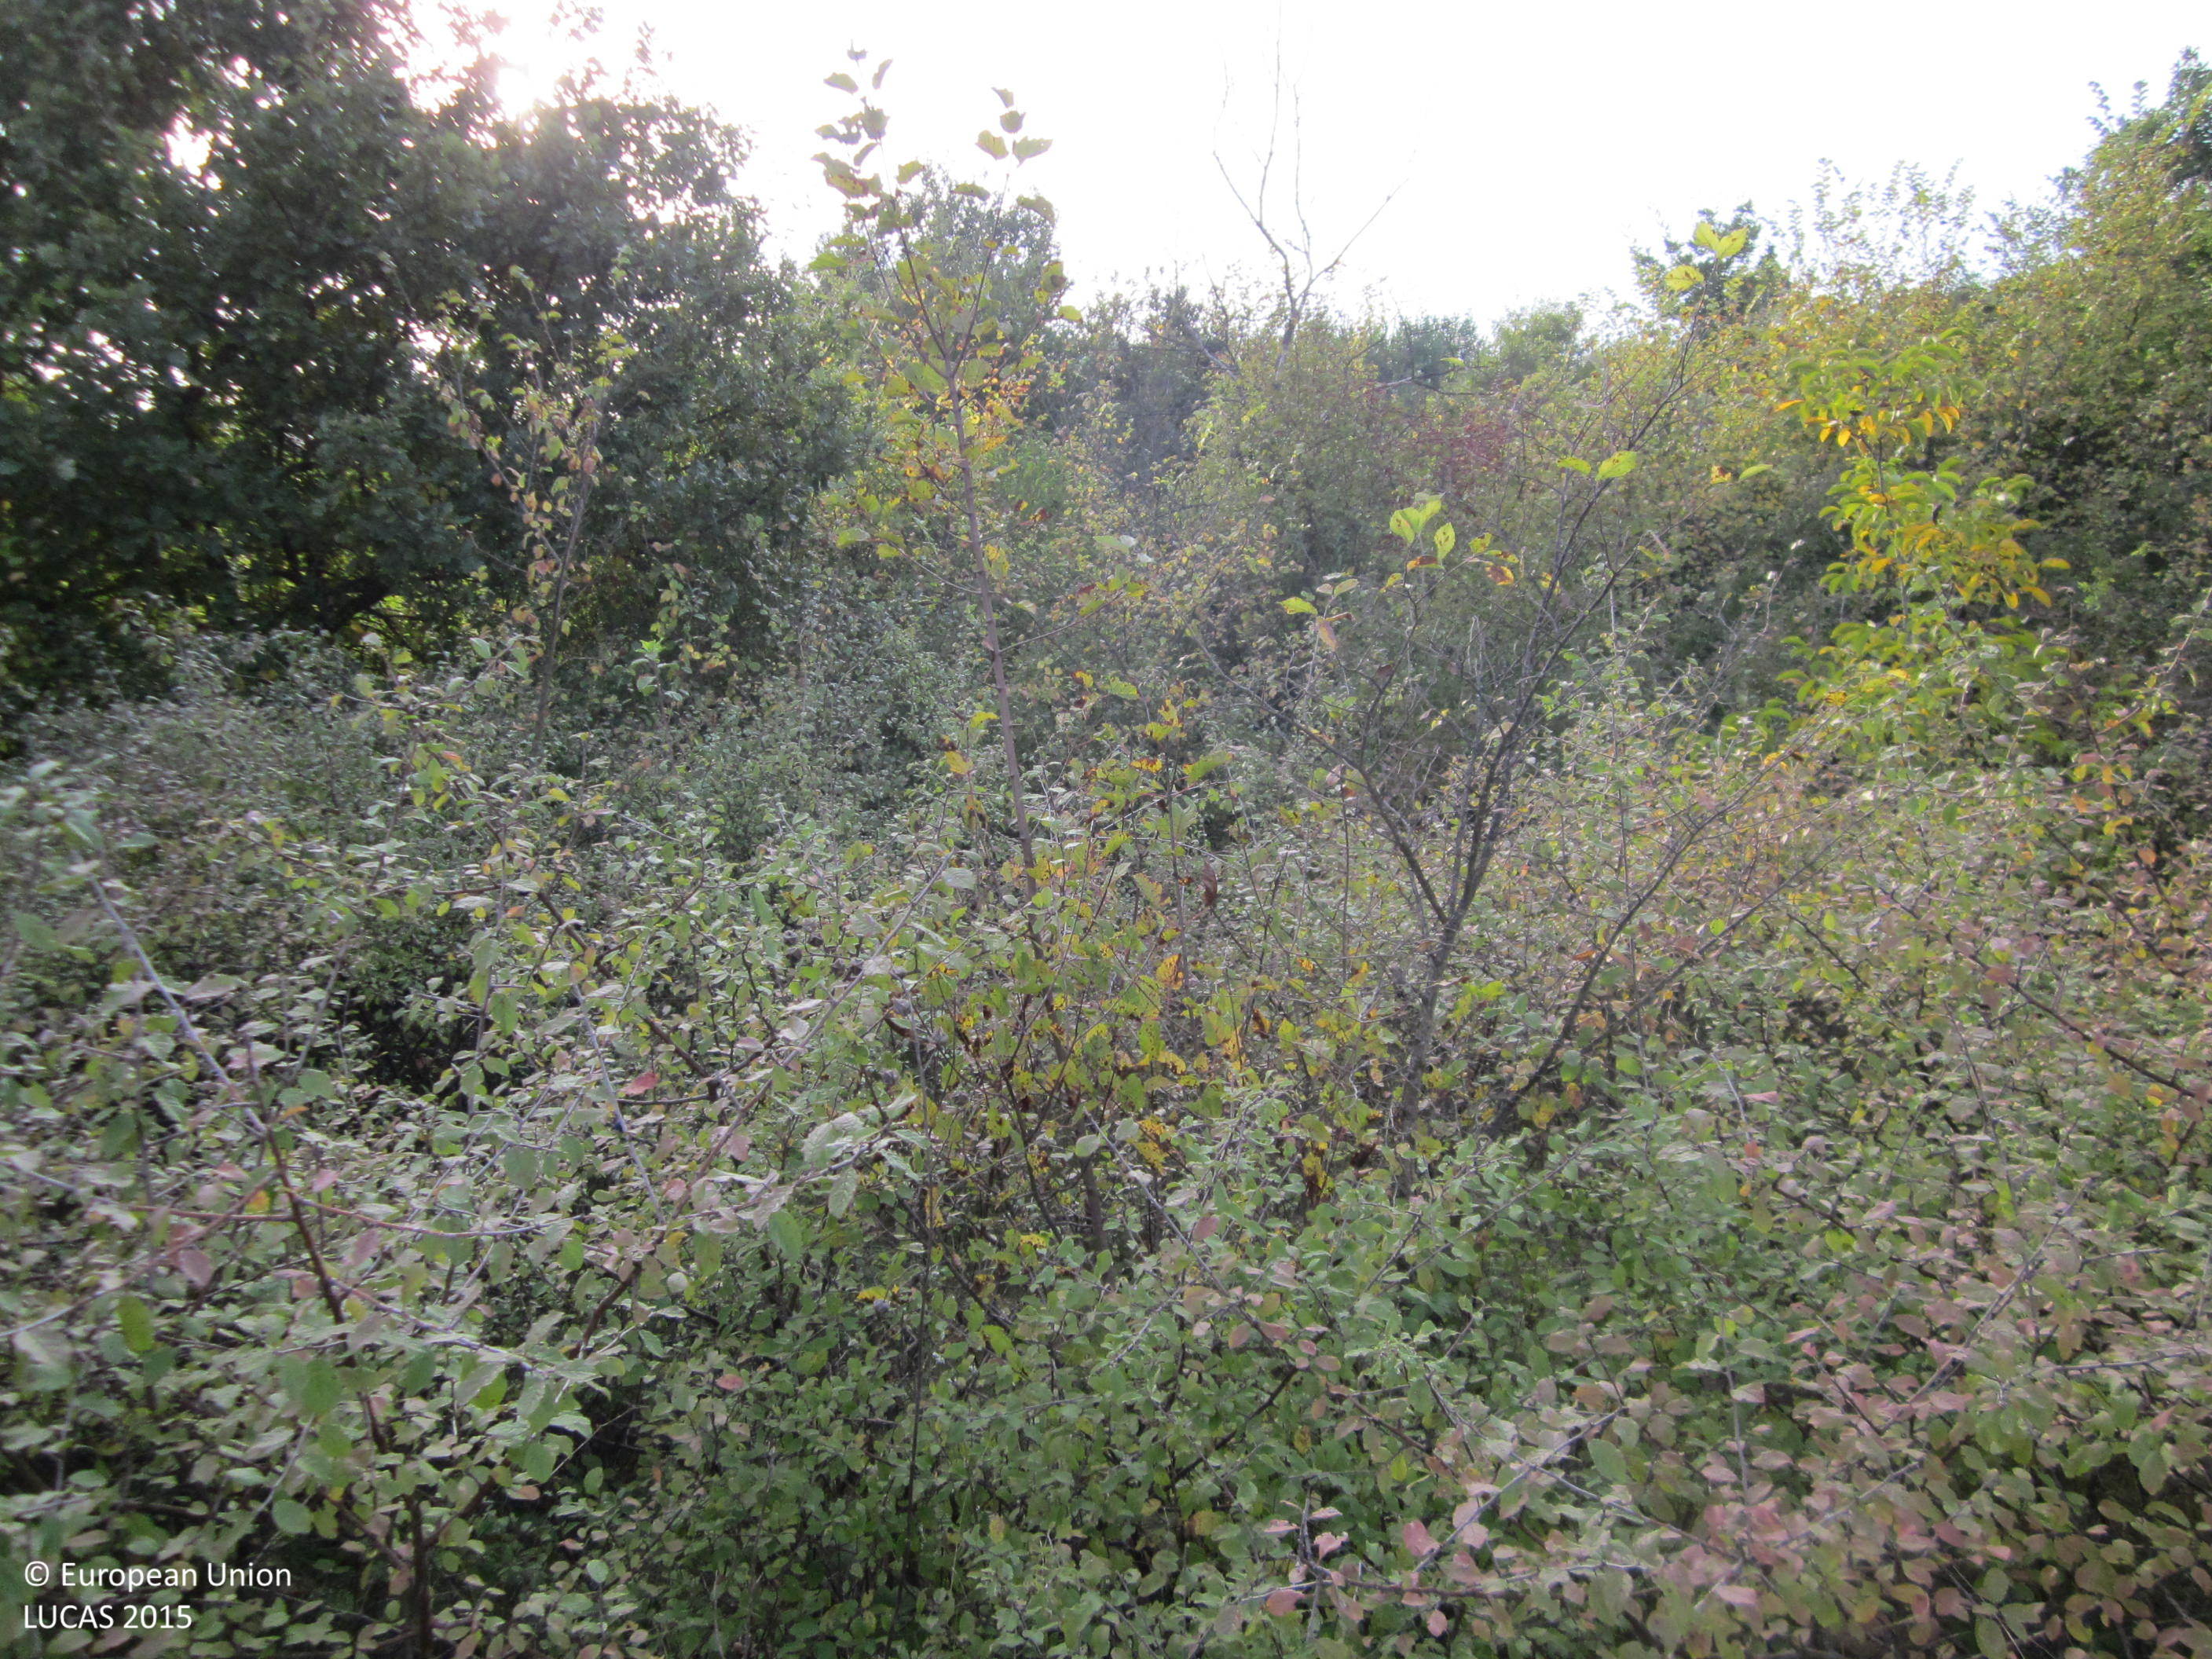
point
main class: Shrubland
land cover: Shrubland with sparse tree cover
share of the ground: 50 - 75 %
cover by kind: shrubs 70 %, herbaceous plants 25 %, broadleaved forest trees 5 %
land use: Semi-natural and natural areas not in use
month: October
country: BG
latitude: 42.7244
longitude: 26.7215
